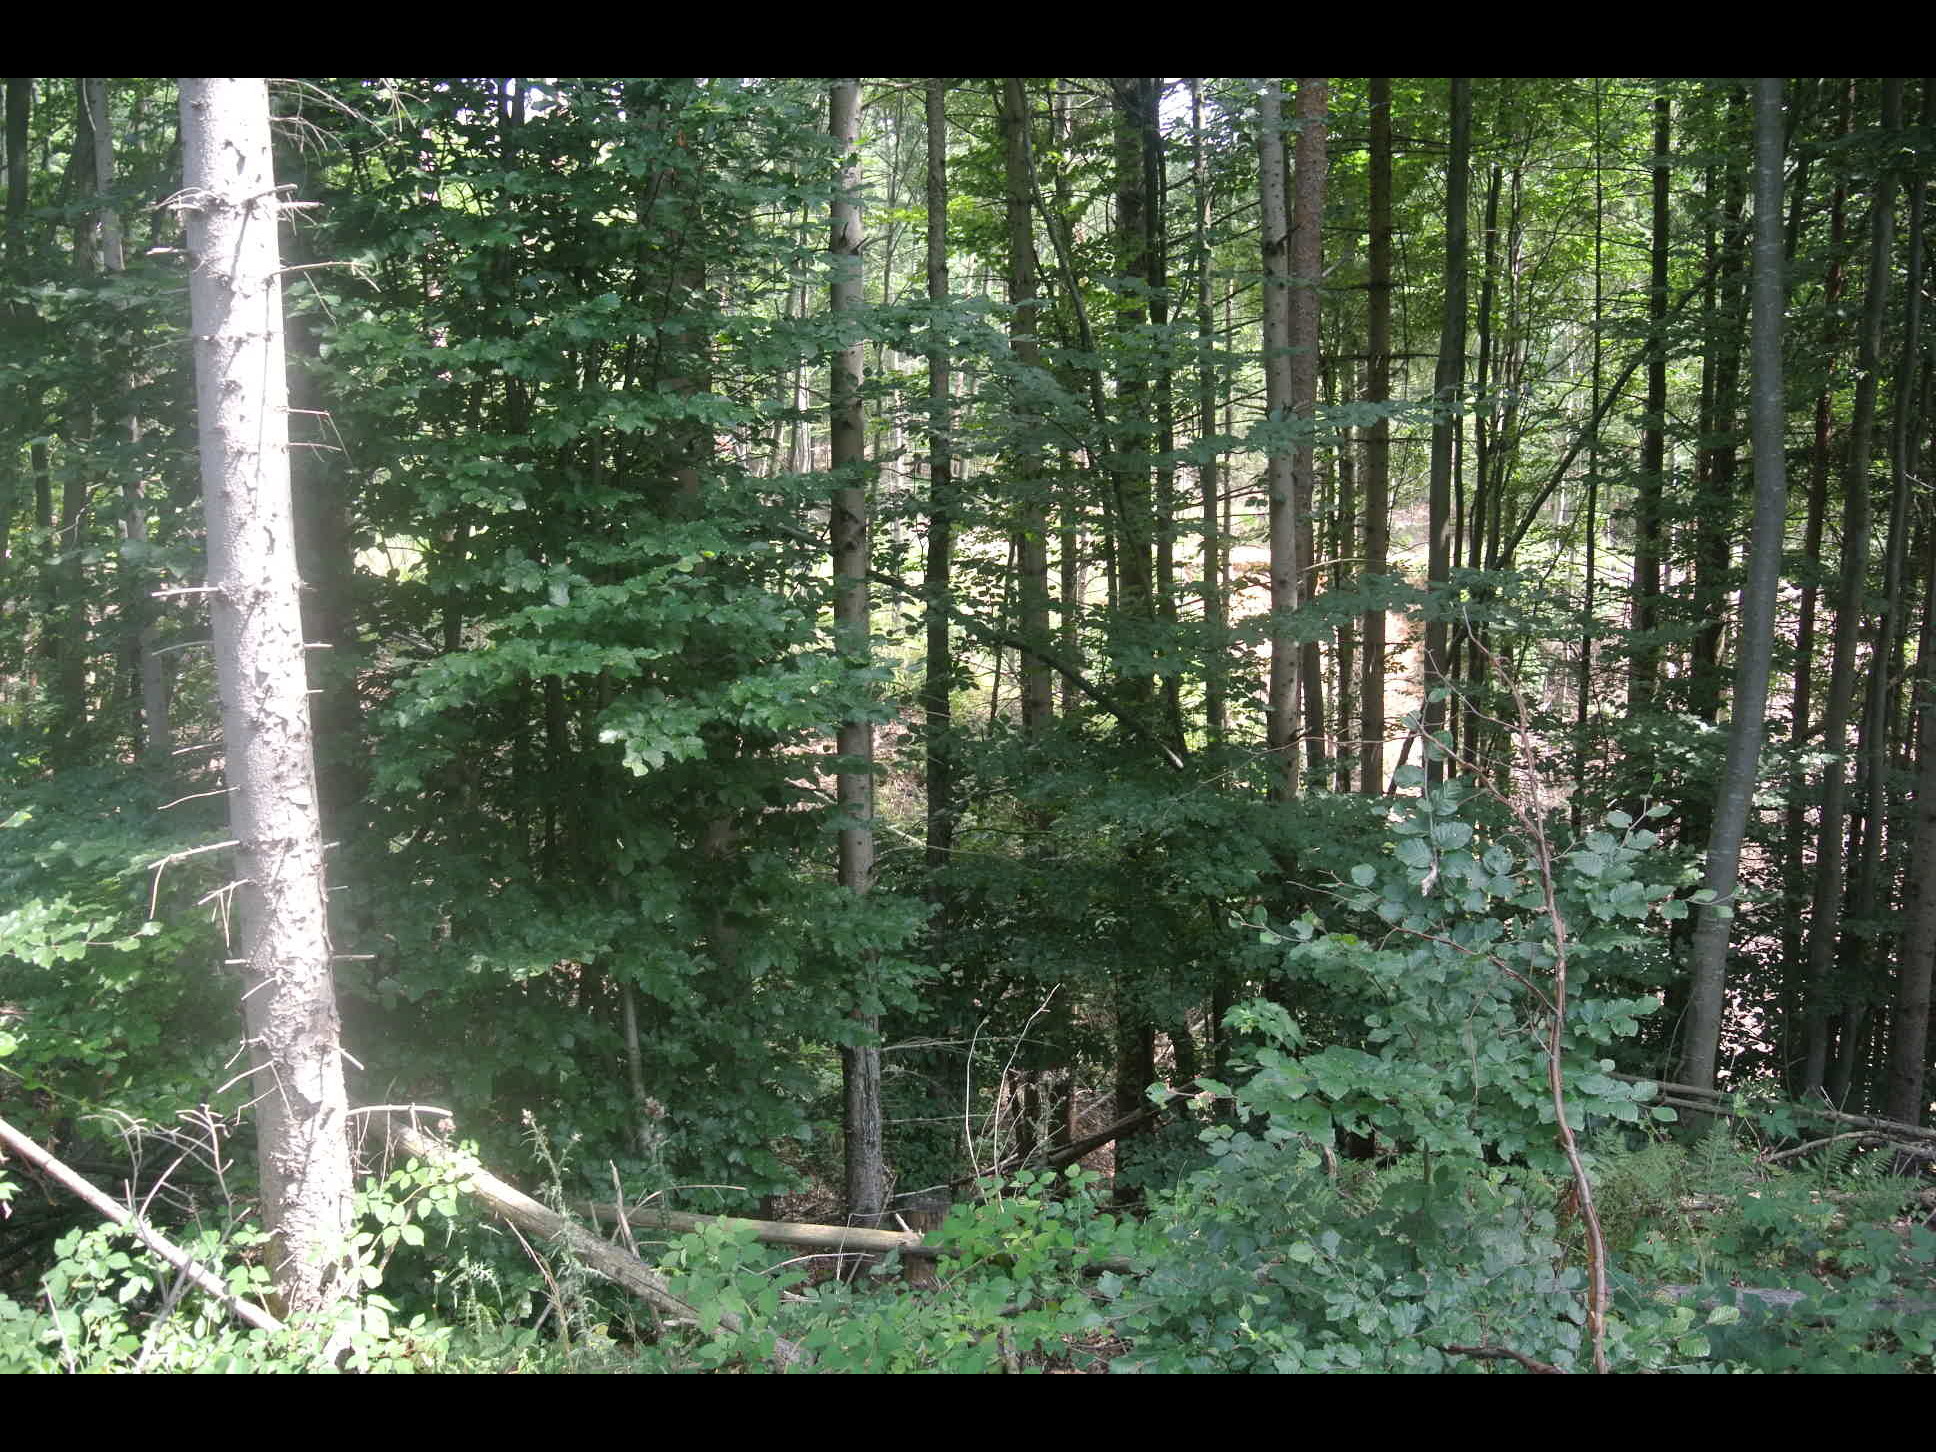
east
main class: Woodland
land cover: Spruce dominated mixed woodland
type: alpine coniferous forest
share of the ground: > 75 %
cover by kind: broadleaved forest trees 70 %, coniferous forest trees 30 %
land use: Forestry
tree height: > 5 m
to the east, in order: Spruce dominated mixed woodland; Rivers and streams; Broadleaved woodland; Tracks; Ditches and canals; Spruce dominated mixed woodland; Other mixed woodland
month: July
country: AT
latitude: 47.4218
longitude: 16.4323
